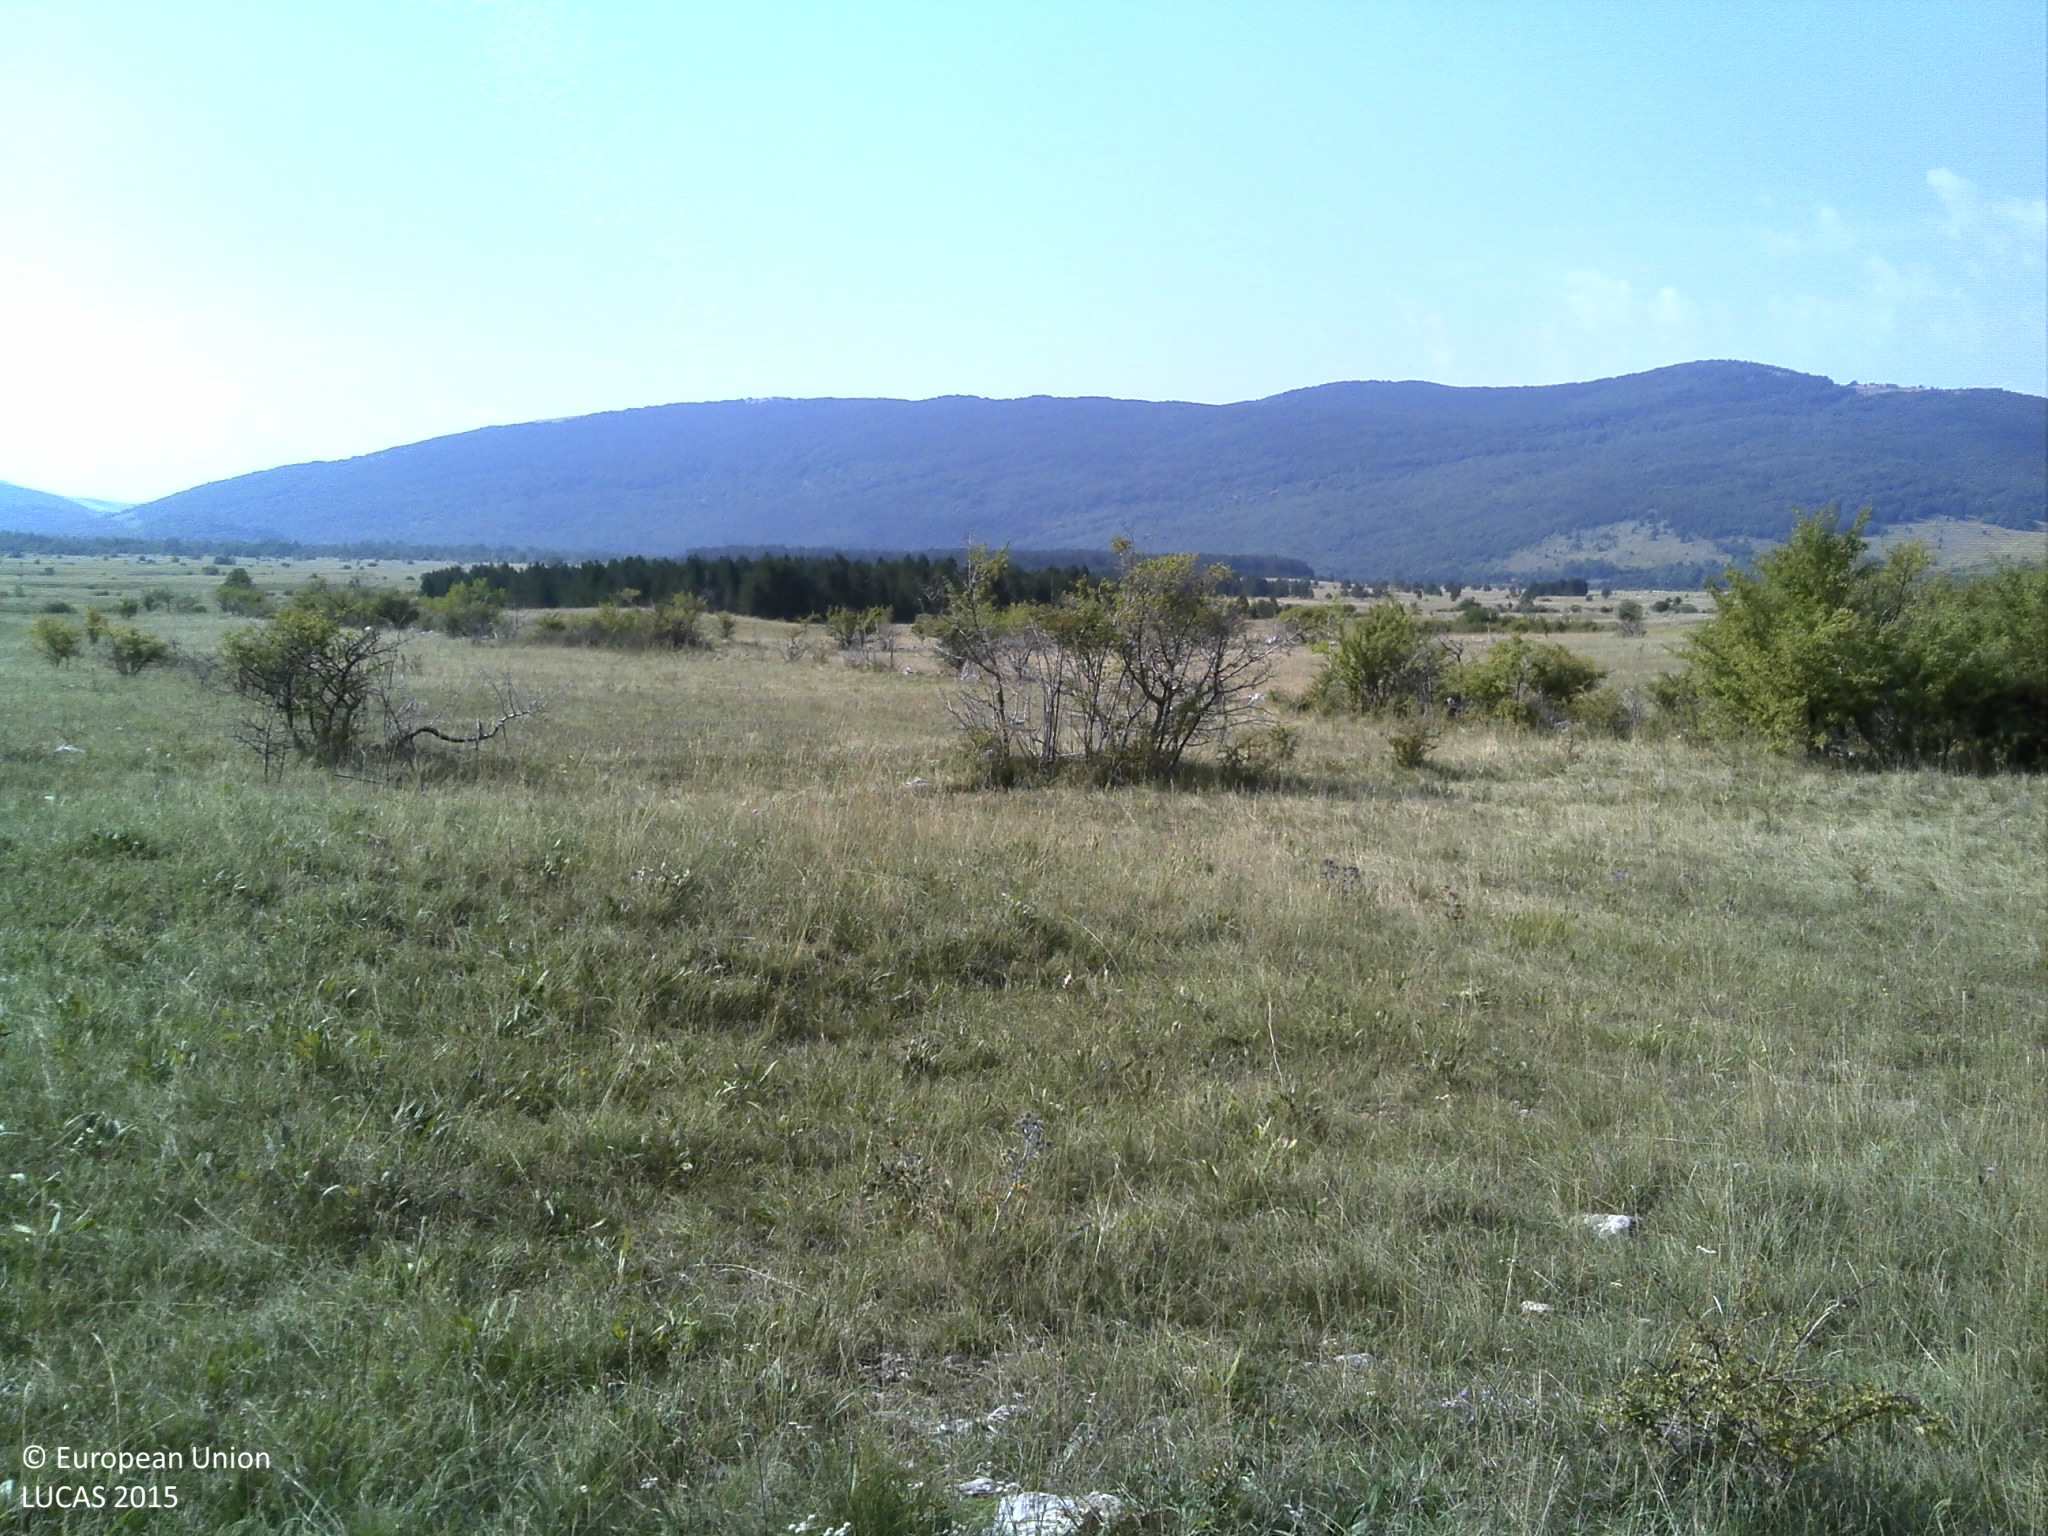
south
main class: Grassland
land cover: Grassland with sparse tree/shrub cover
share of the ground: > 75 %
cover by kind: herbaceous plants 85 %, shrubs 10 %, broadleaved forest trees 5 %
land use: Semi-natural and natural areas not in use
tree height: < 5 m
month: September
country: HR
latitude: 44.3604
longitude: 15.9532
